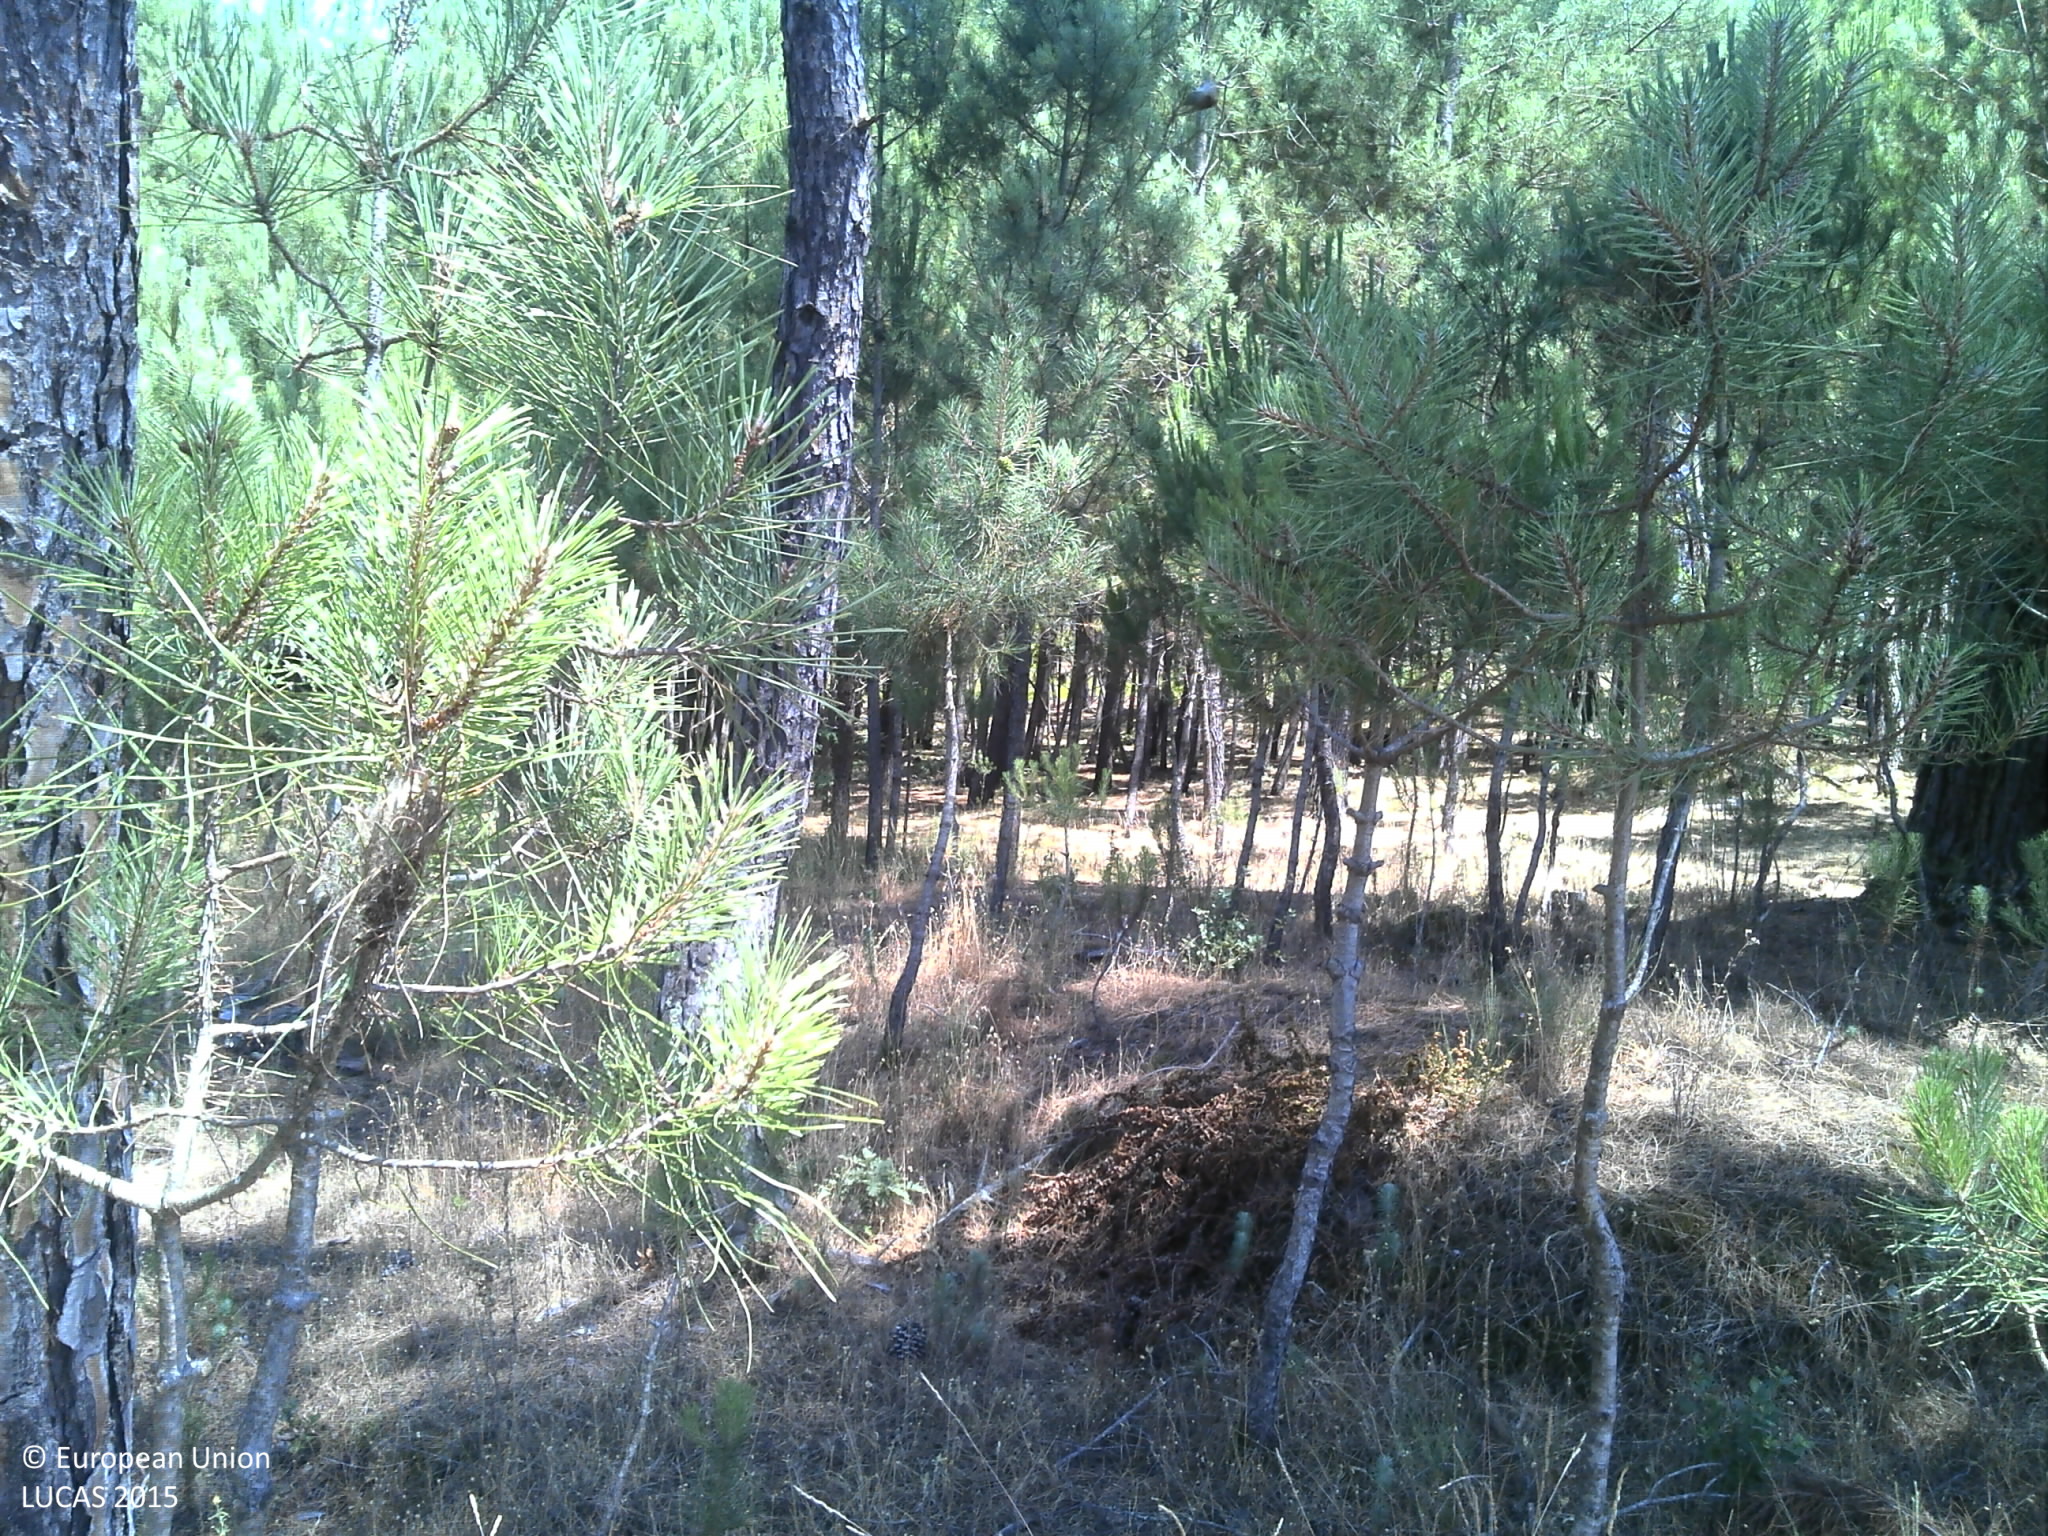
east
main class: Woodland
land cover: Pine dominated coniferous woodland
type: coniferous forest of the mediterranean region
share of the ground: 50 - 75 %
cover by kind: coniferous forest trees 60 %, unconsolidated bare surface 25 %, shrubs 10 %, herbaceous plants 5 %
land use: Forestry
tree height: > 5 m
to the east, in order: Pine dominated coniferous woodland; Shrubland without tree cover; Tracks; Shrubland without tree cover; Pine dominated coniferous woodland; Rock outcrops; Pine dominated coniferous woodland; Tracks; Pine dominated coniferous woodland; Grassland with sparse tree/shrub cover
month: July
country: PT
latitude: 40.3939
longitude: -7.9215
